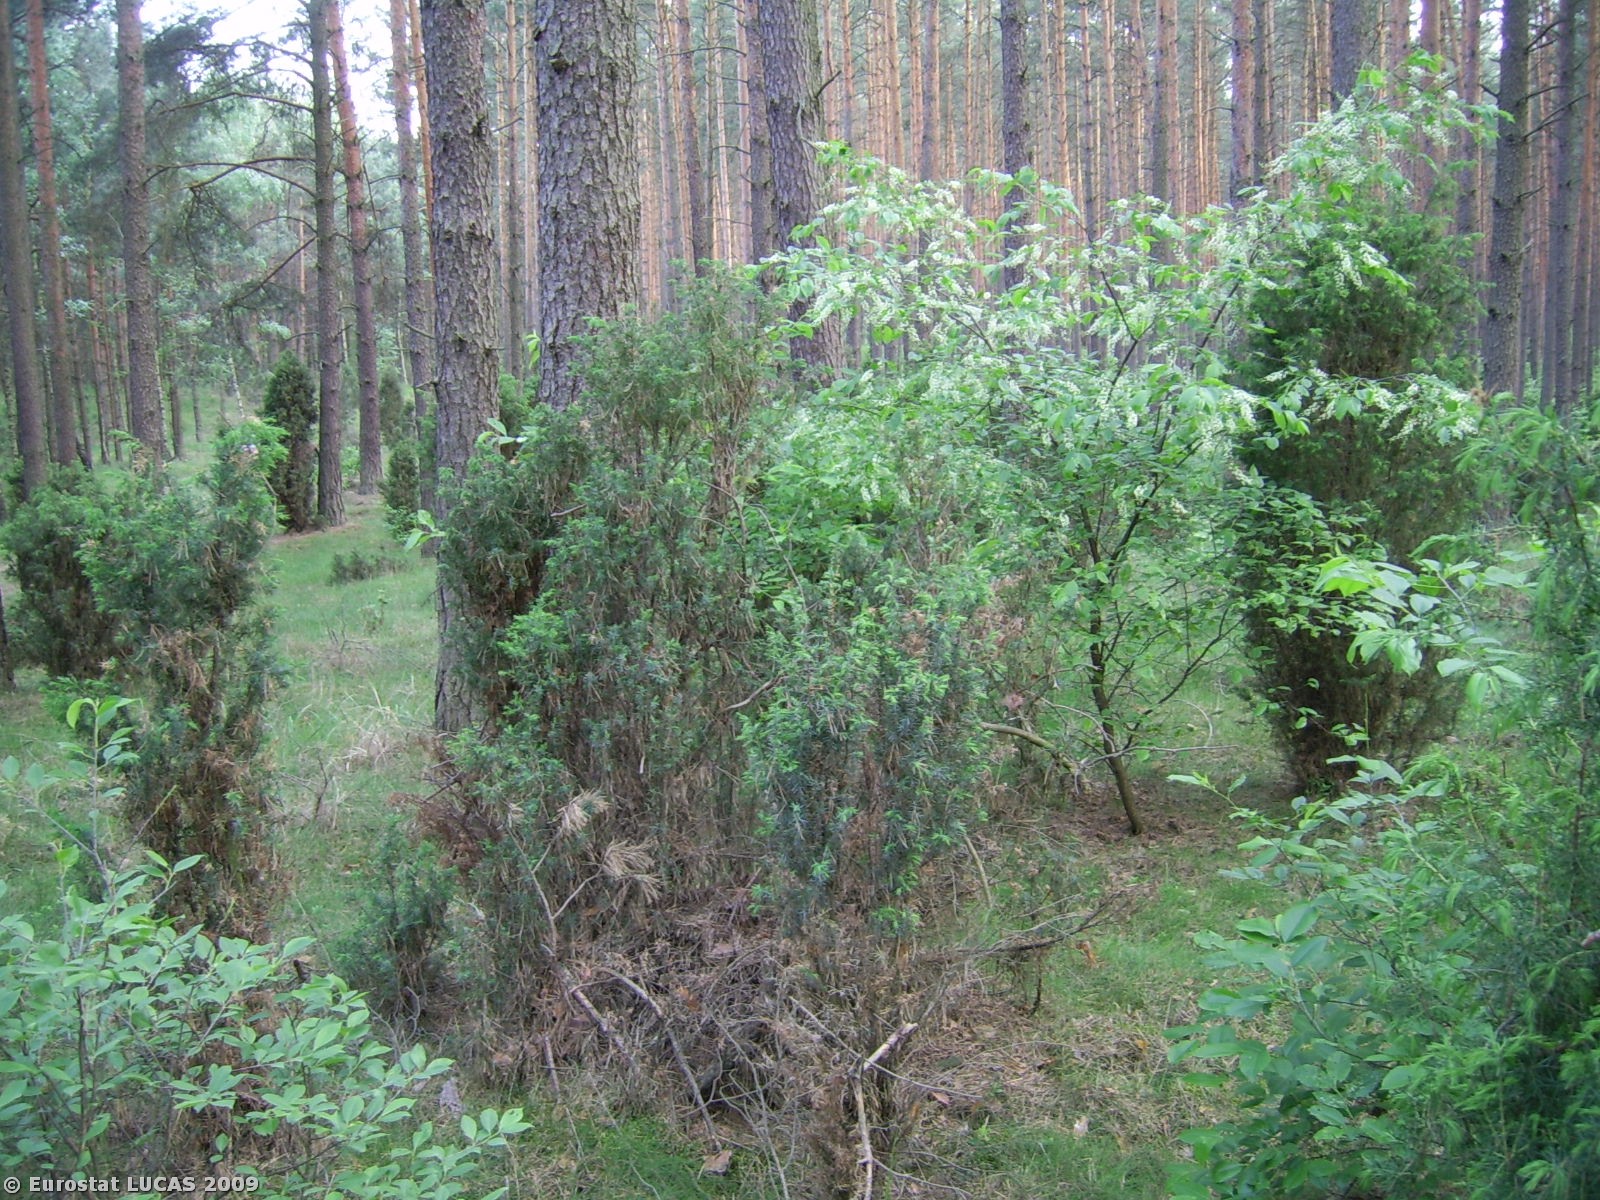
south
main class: Woodland
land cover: Coniferous woodland
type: hemiboreal forest and nemoral coniferous forest and mixed broadleaved-coniferous forest
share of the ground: > 75 %
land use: Forestry
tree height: > 5 m
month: May
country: PL
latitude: 53.0450
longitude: 18.0253
